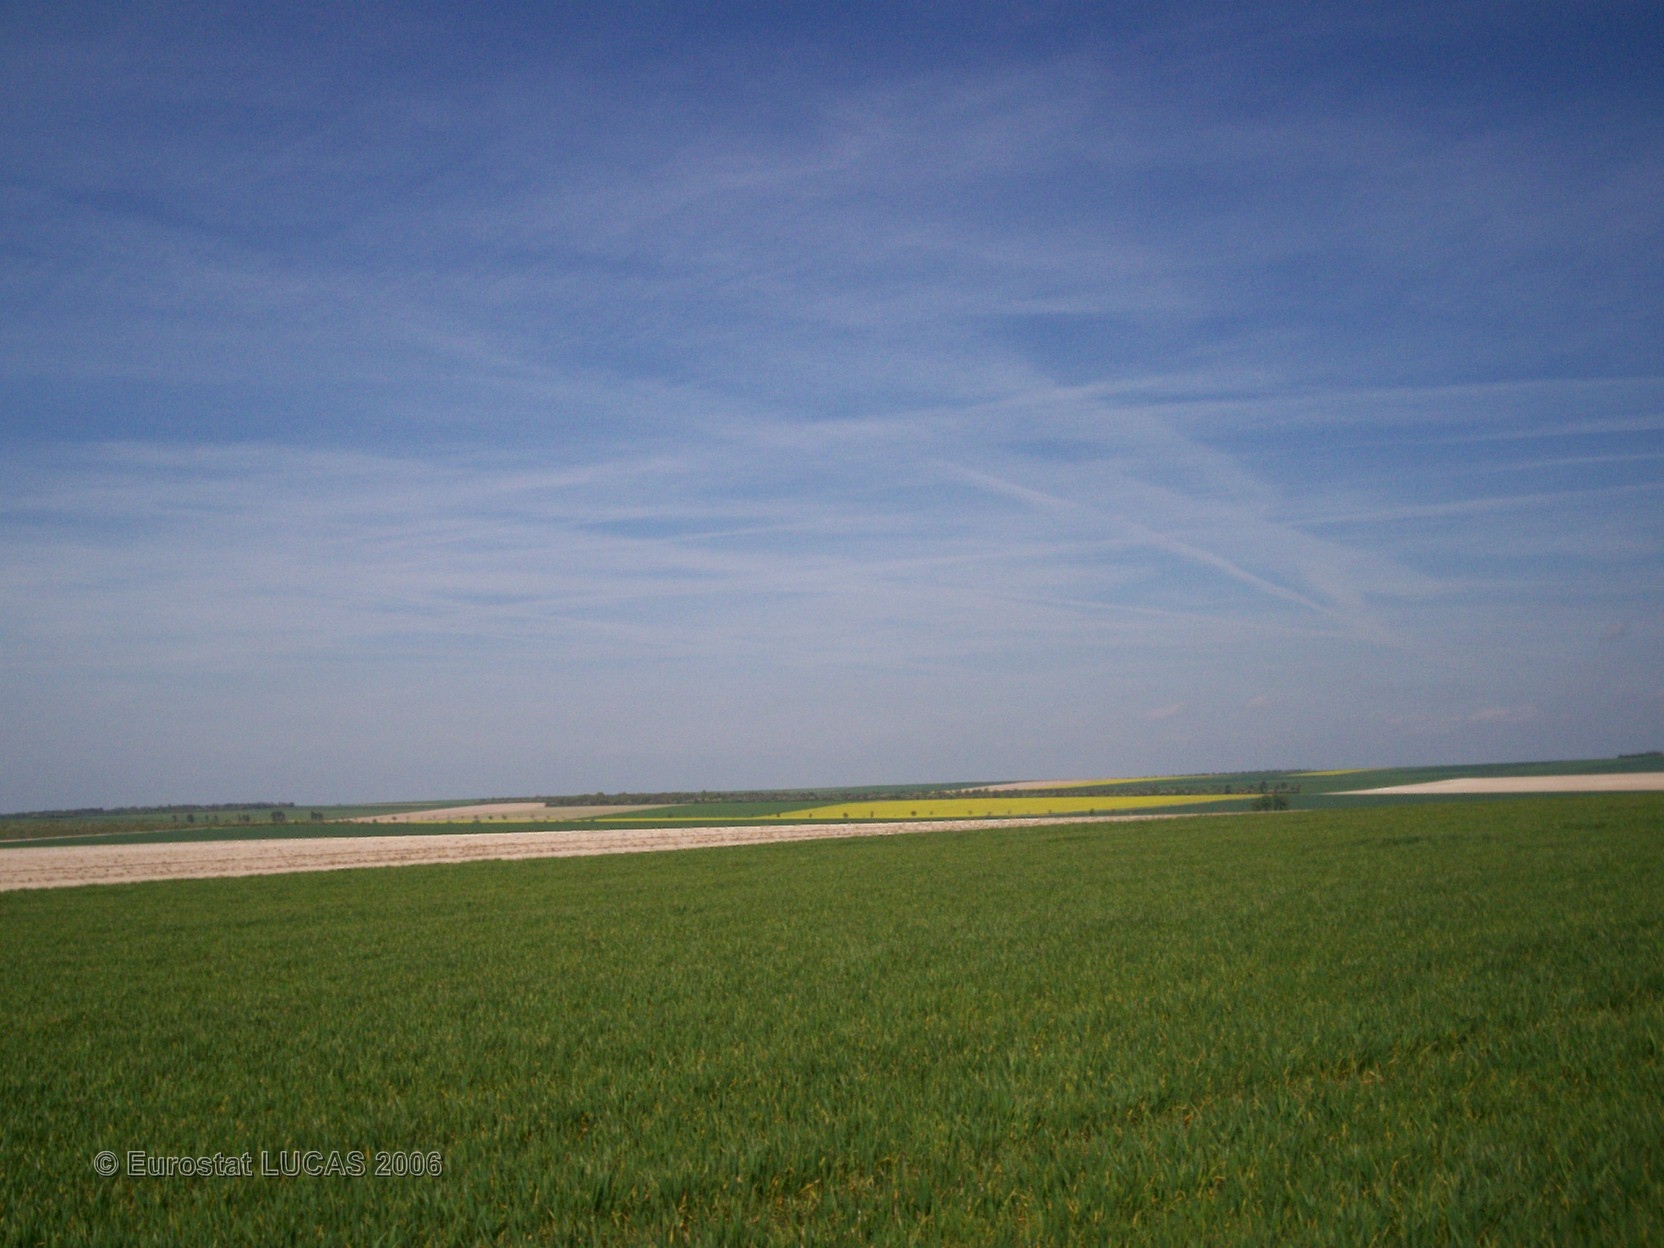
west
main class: Cropland
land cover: Common wheat
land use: Agriculture (excluding fallow land and kitchen gardens)
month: May
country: FR
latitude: 48.8565
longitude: 4.3947
